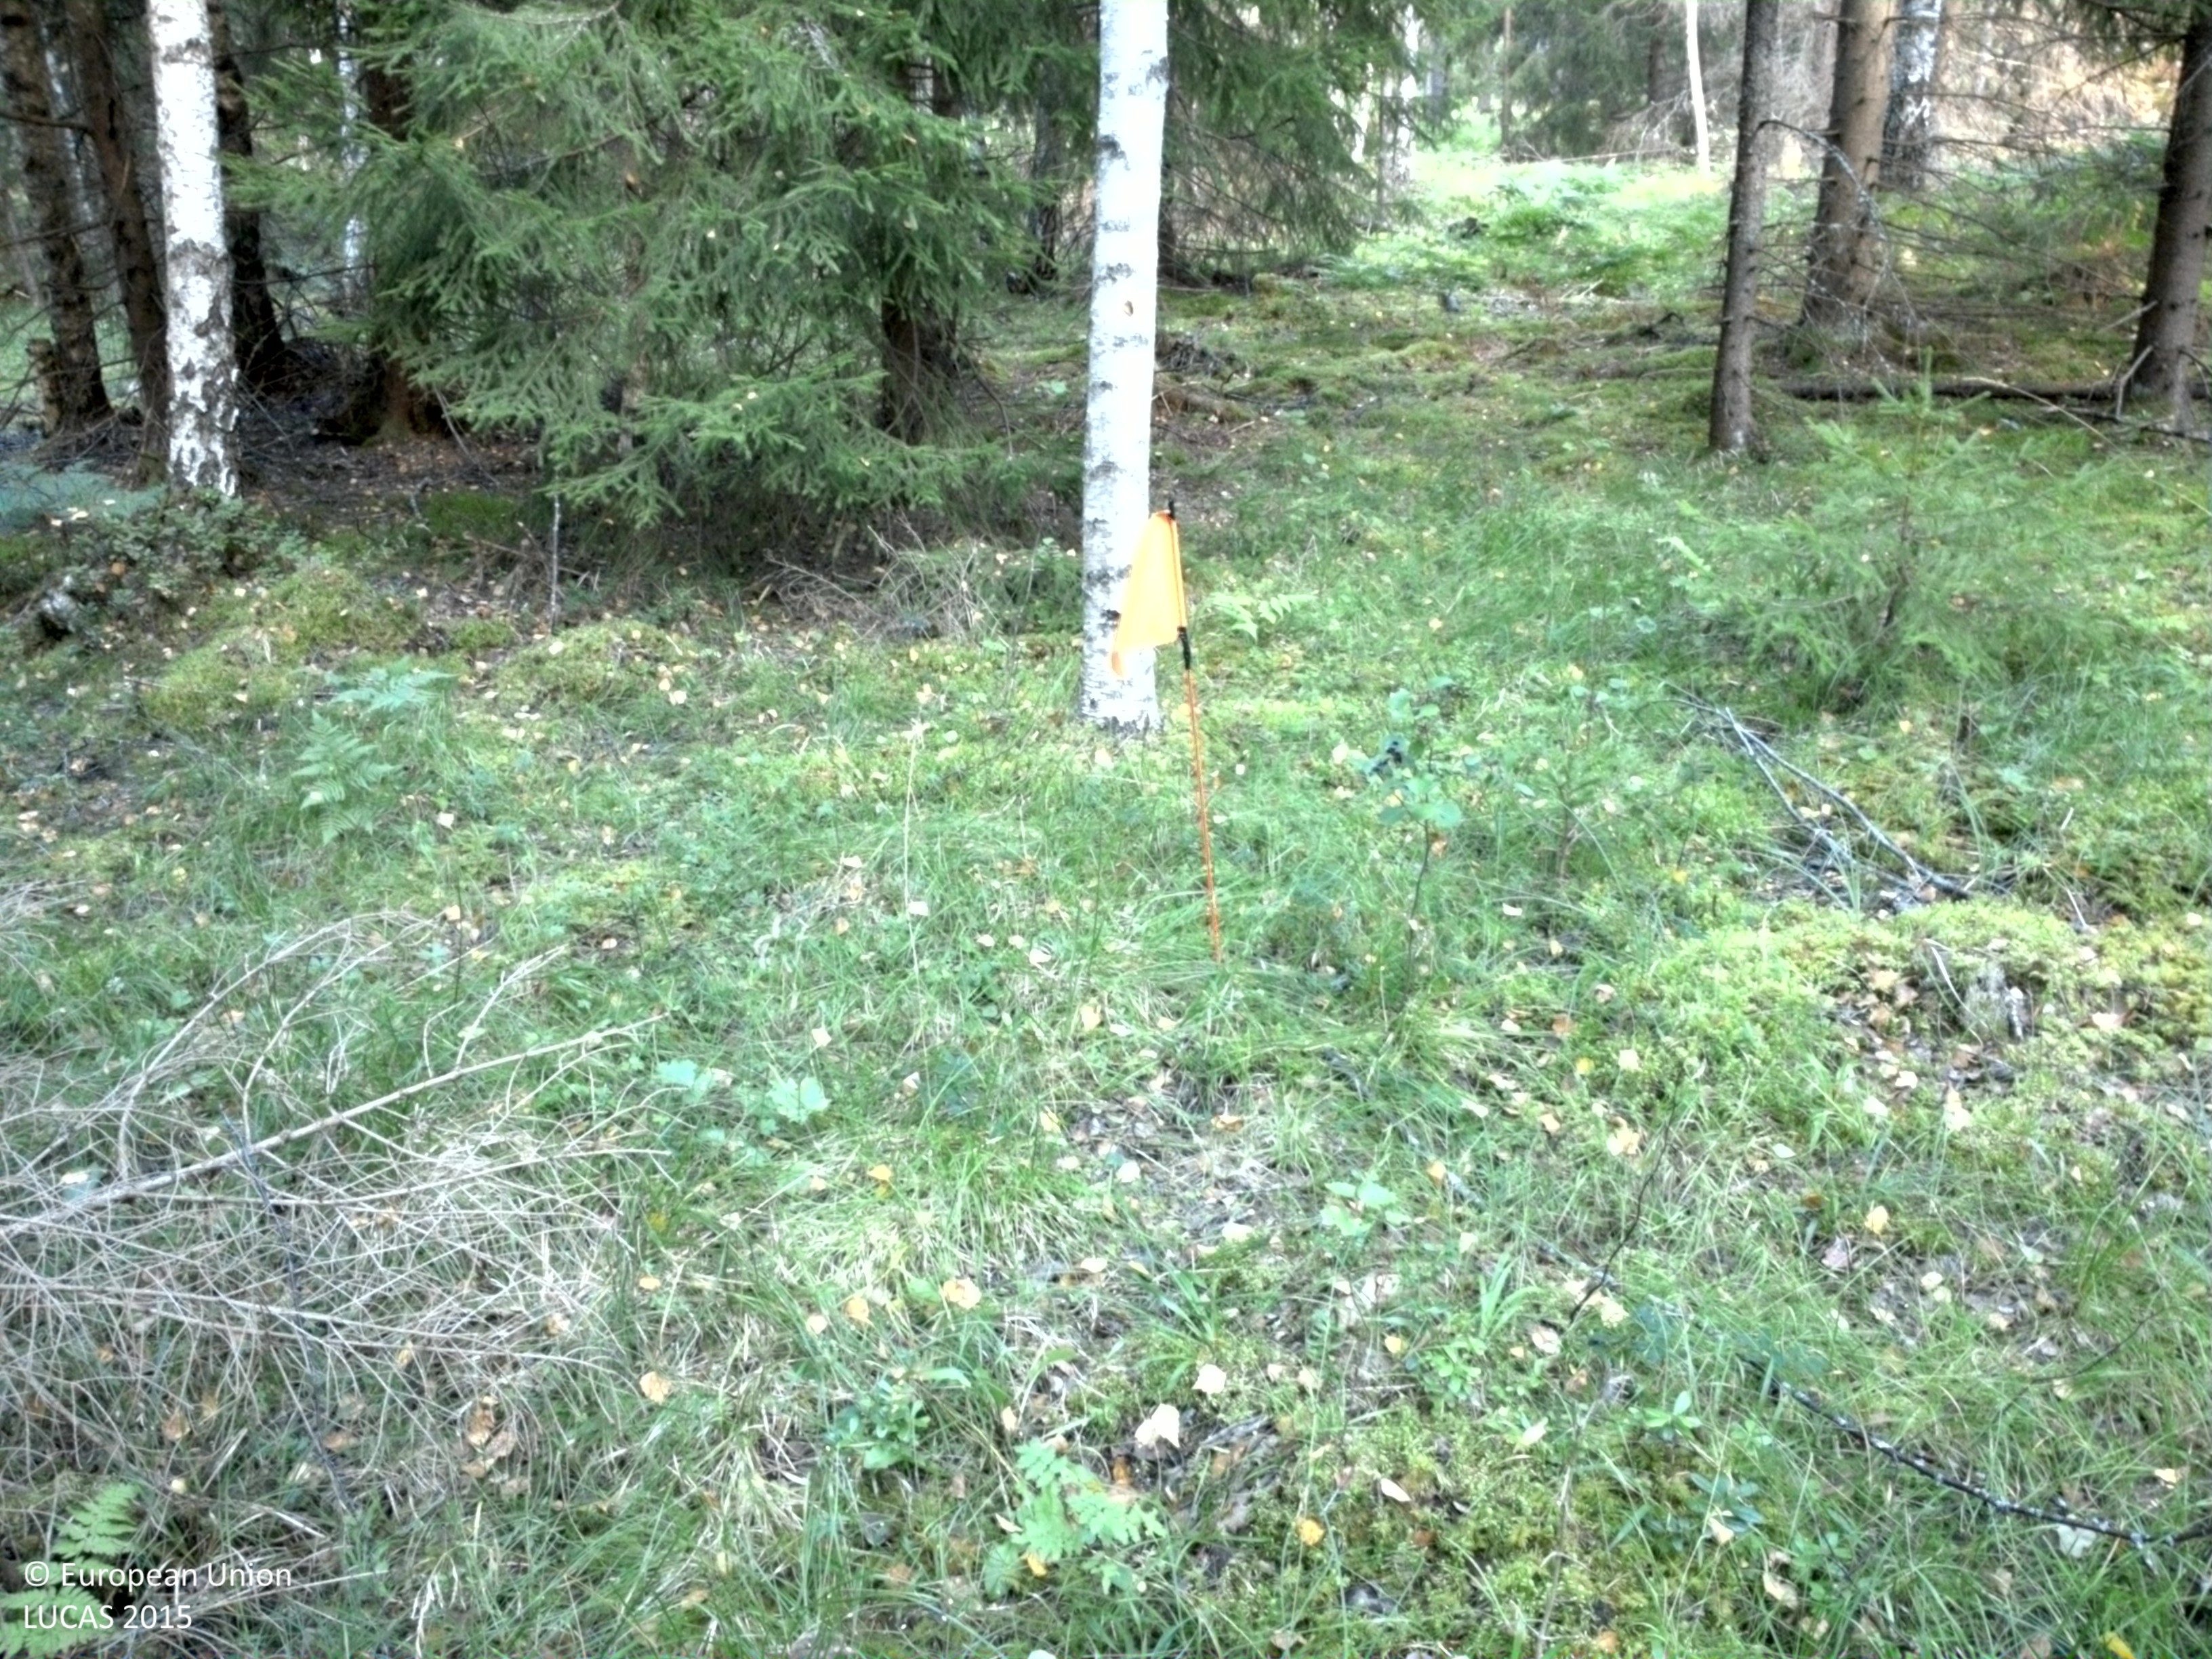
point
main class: Woodland
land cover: Spruce dominated mixed woodland
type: boreal forest
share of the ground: 50 - 75 %
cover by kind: coniferous forest trees 45 %, herbaceous plants 40 %, broadleaved forest trees 15 %
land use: Forestry
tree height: > 5 m
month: August
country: SE
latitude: 59.7078
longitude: 17.1918
